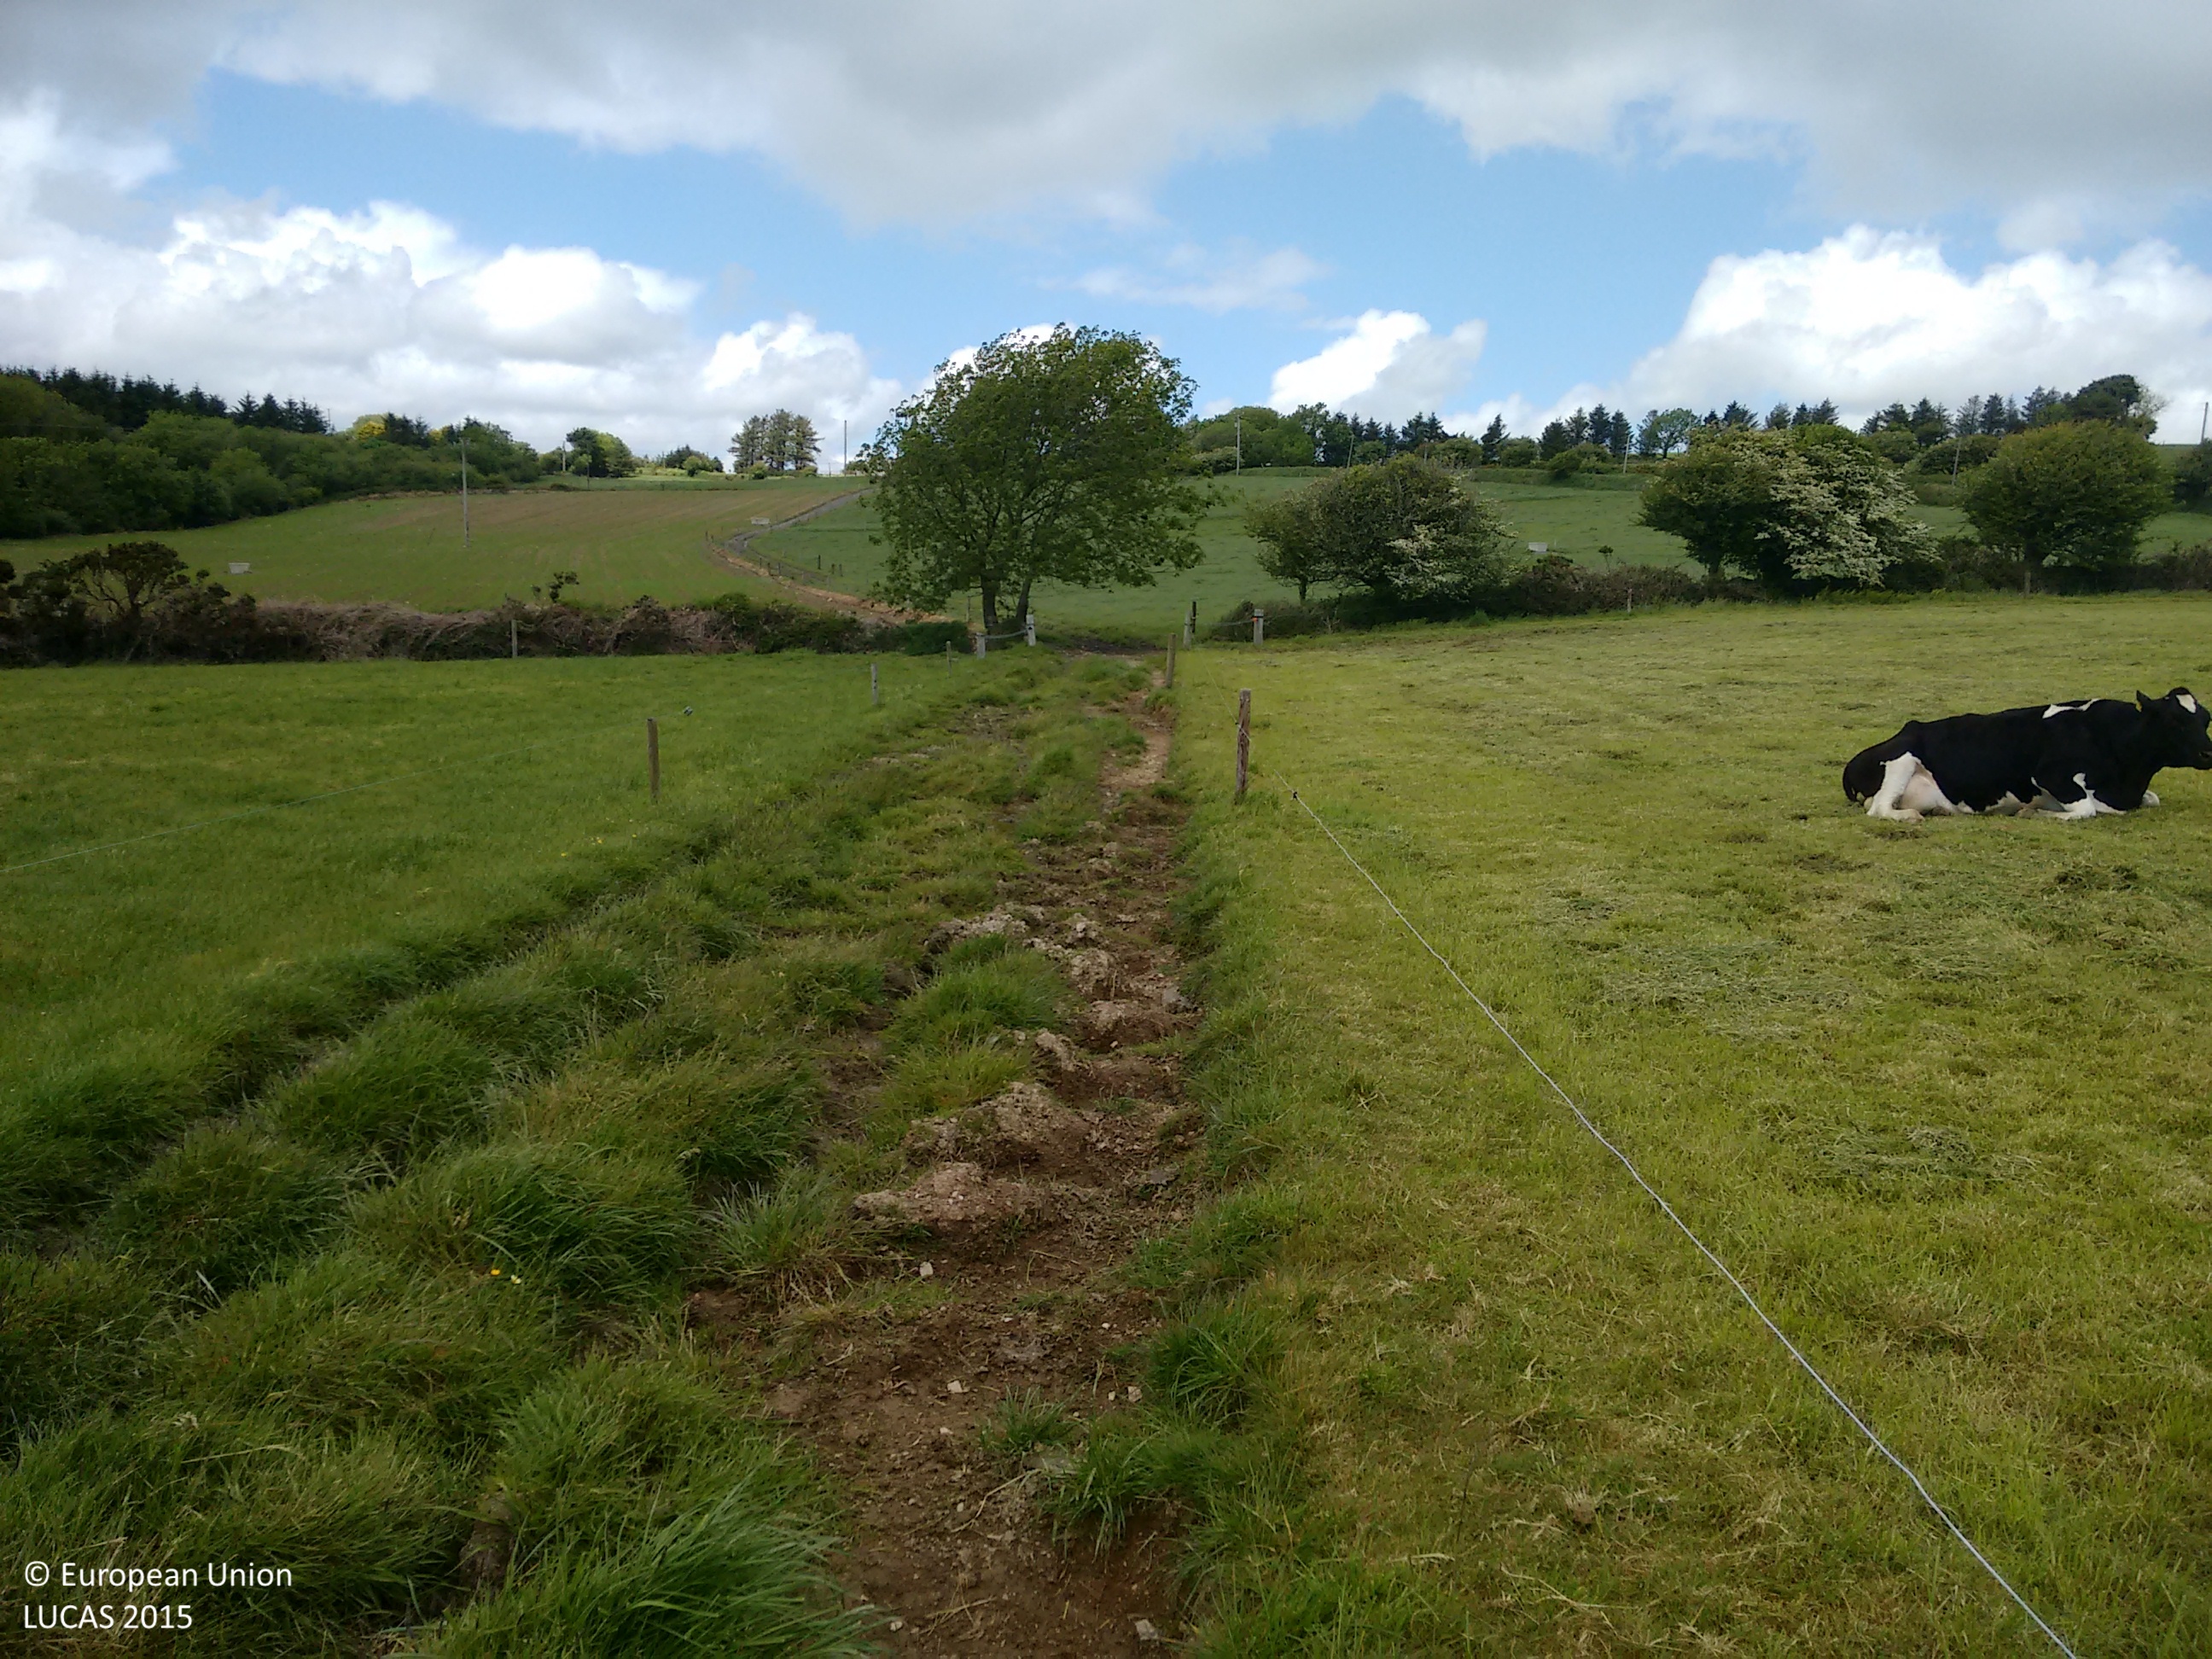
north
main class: Grassland
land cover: Grassland without tree/shrub cover
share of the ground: > 75 %
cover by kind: herbaceous plants 100 %
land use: Agriculture (excluding fallow land and kitchen gardens)
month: June
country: IE
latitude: 51.6800
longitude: -8.7292
